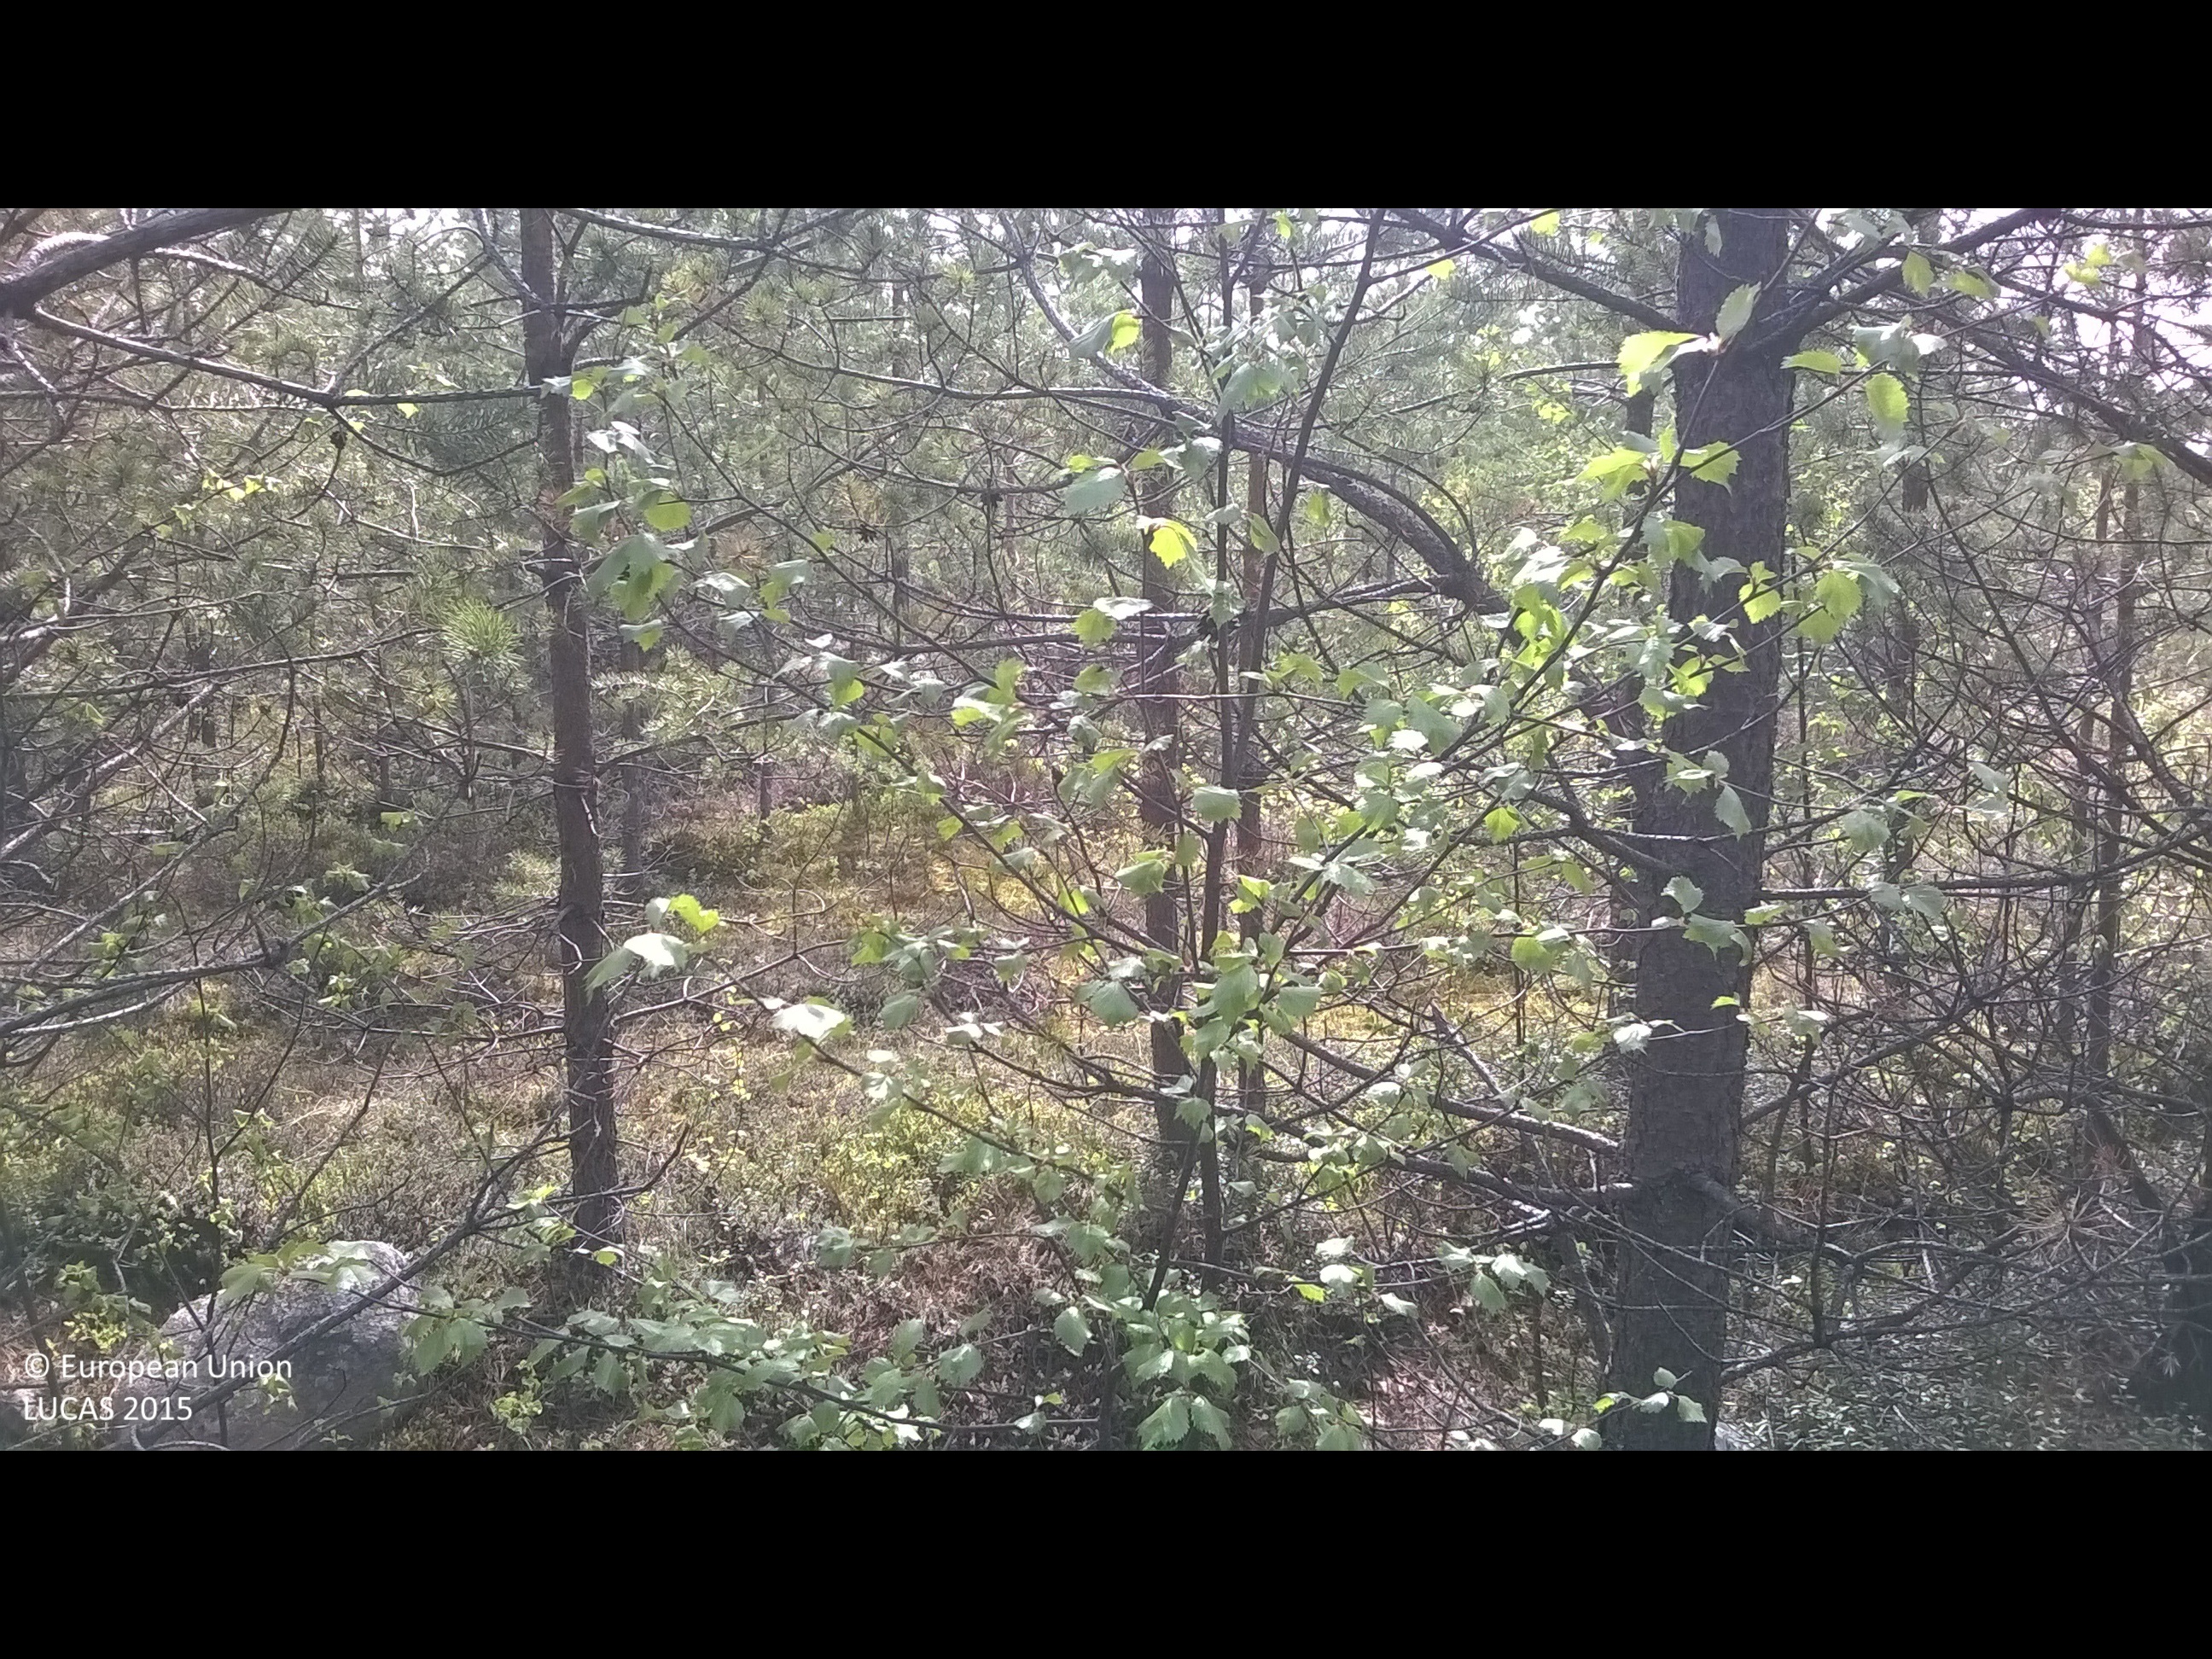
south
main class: Woodland
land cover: Pine dominated coniferous woodland
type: boreal forest
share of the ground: > 75 %
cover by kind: coniferous forest trees 90 %, broadleaved forest trees 5 %, shrubs 5 %
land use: Forestry
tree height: < 5 m
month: June
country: FI
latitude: 66.5653
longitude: 26.5591
